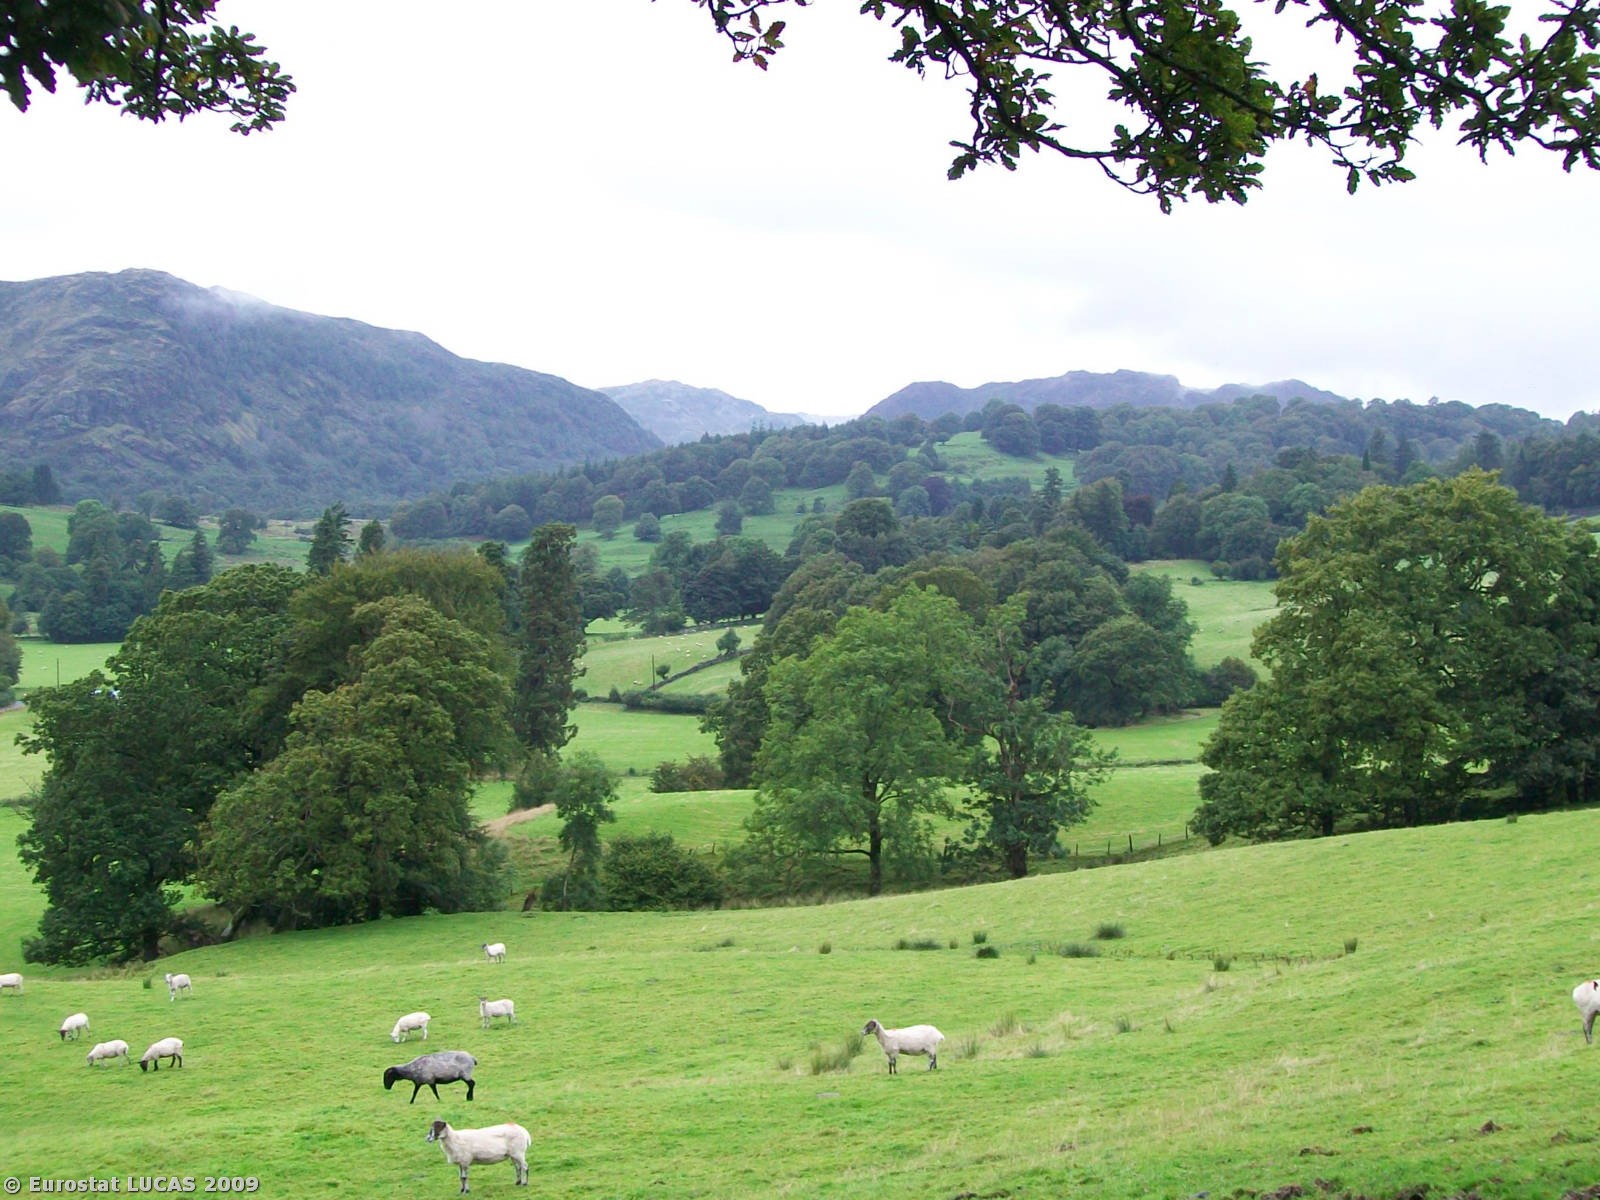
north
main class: Grassland
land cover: Grassland with sparse tree/shrub cover
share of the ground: > 75 %
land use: Agriculture (excluding fallow land and kitchen gardens)
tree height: > 5 m
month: August
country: GB
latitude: 54.3688
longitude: -3.0492
